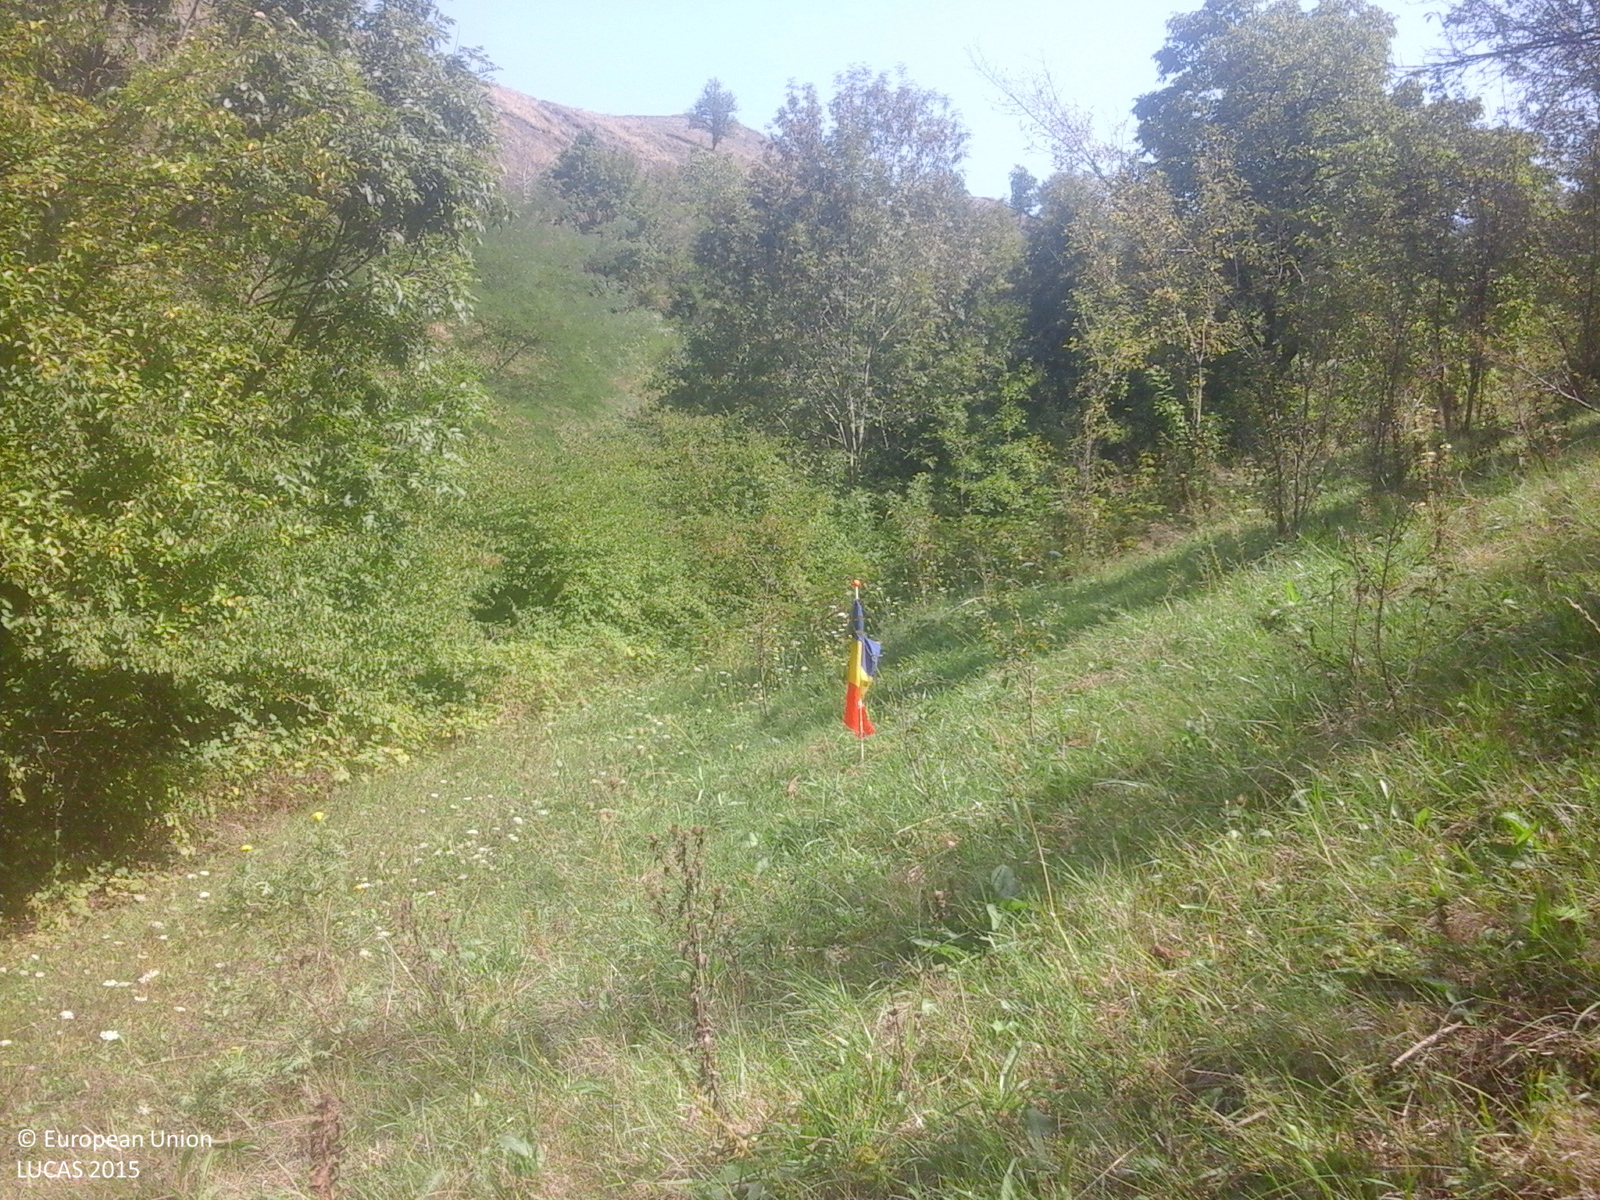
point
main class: Cropland
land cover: Other fruit trees and berries
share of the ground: > 75 %
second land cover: Grassland without tree/shrub cover
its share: > 75 %
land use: Agriculture (excluding fallow land and kitchen gardens)
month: August
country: RO
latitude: 46.1324
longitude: 22.4351
